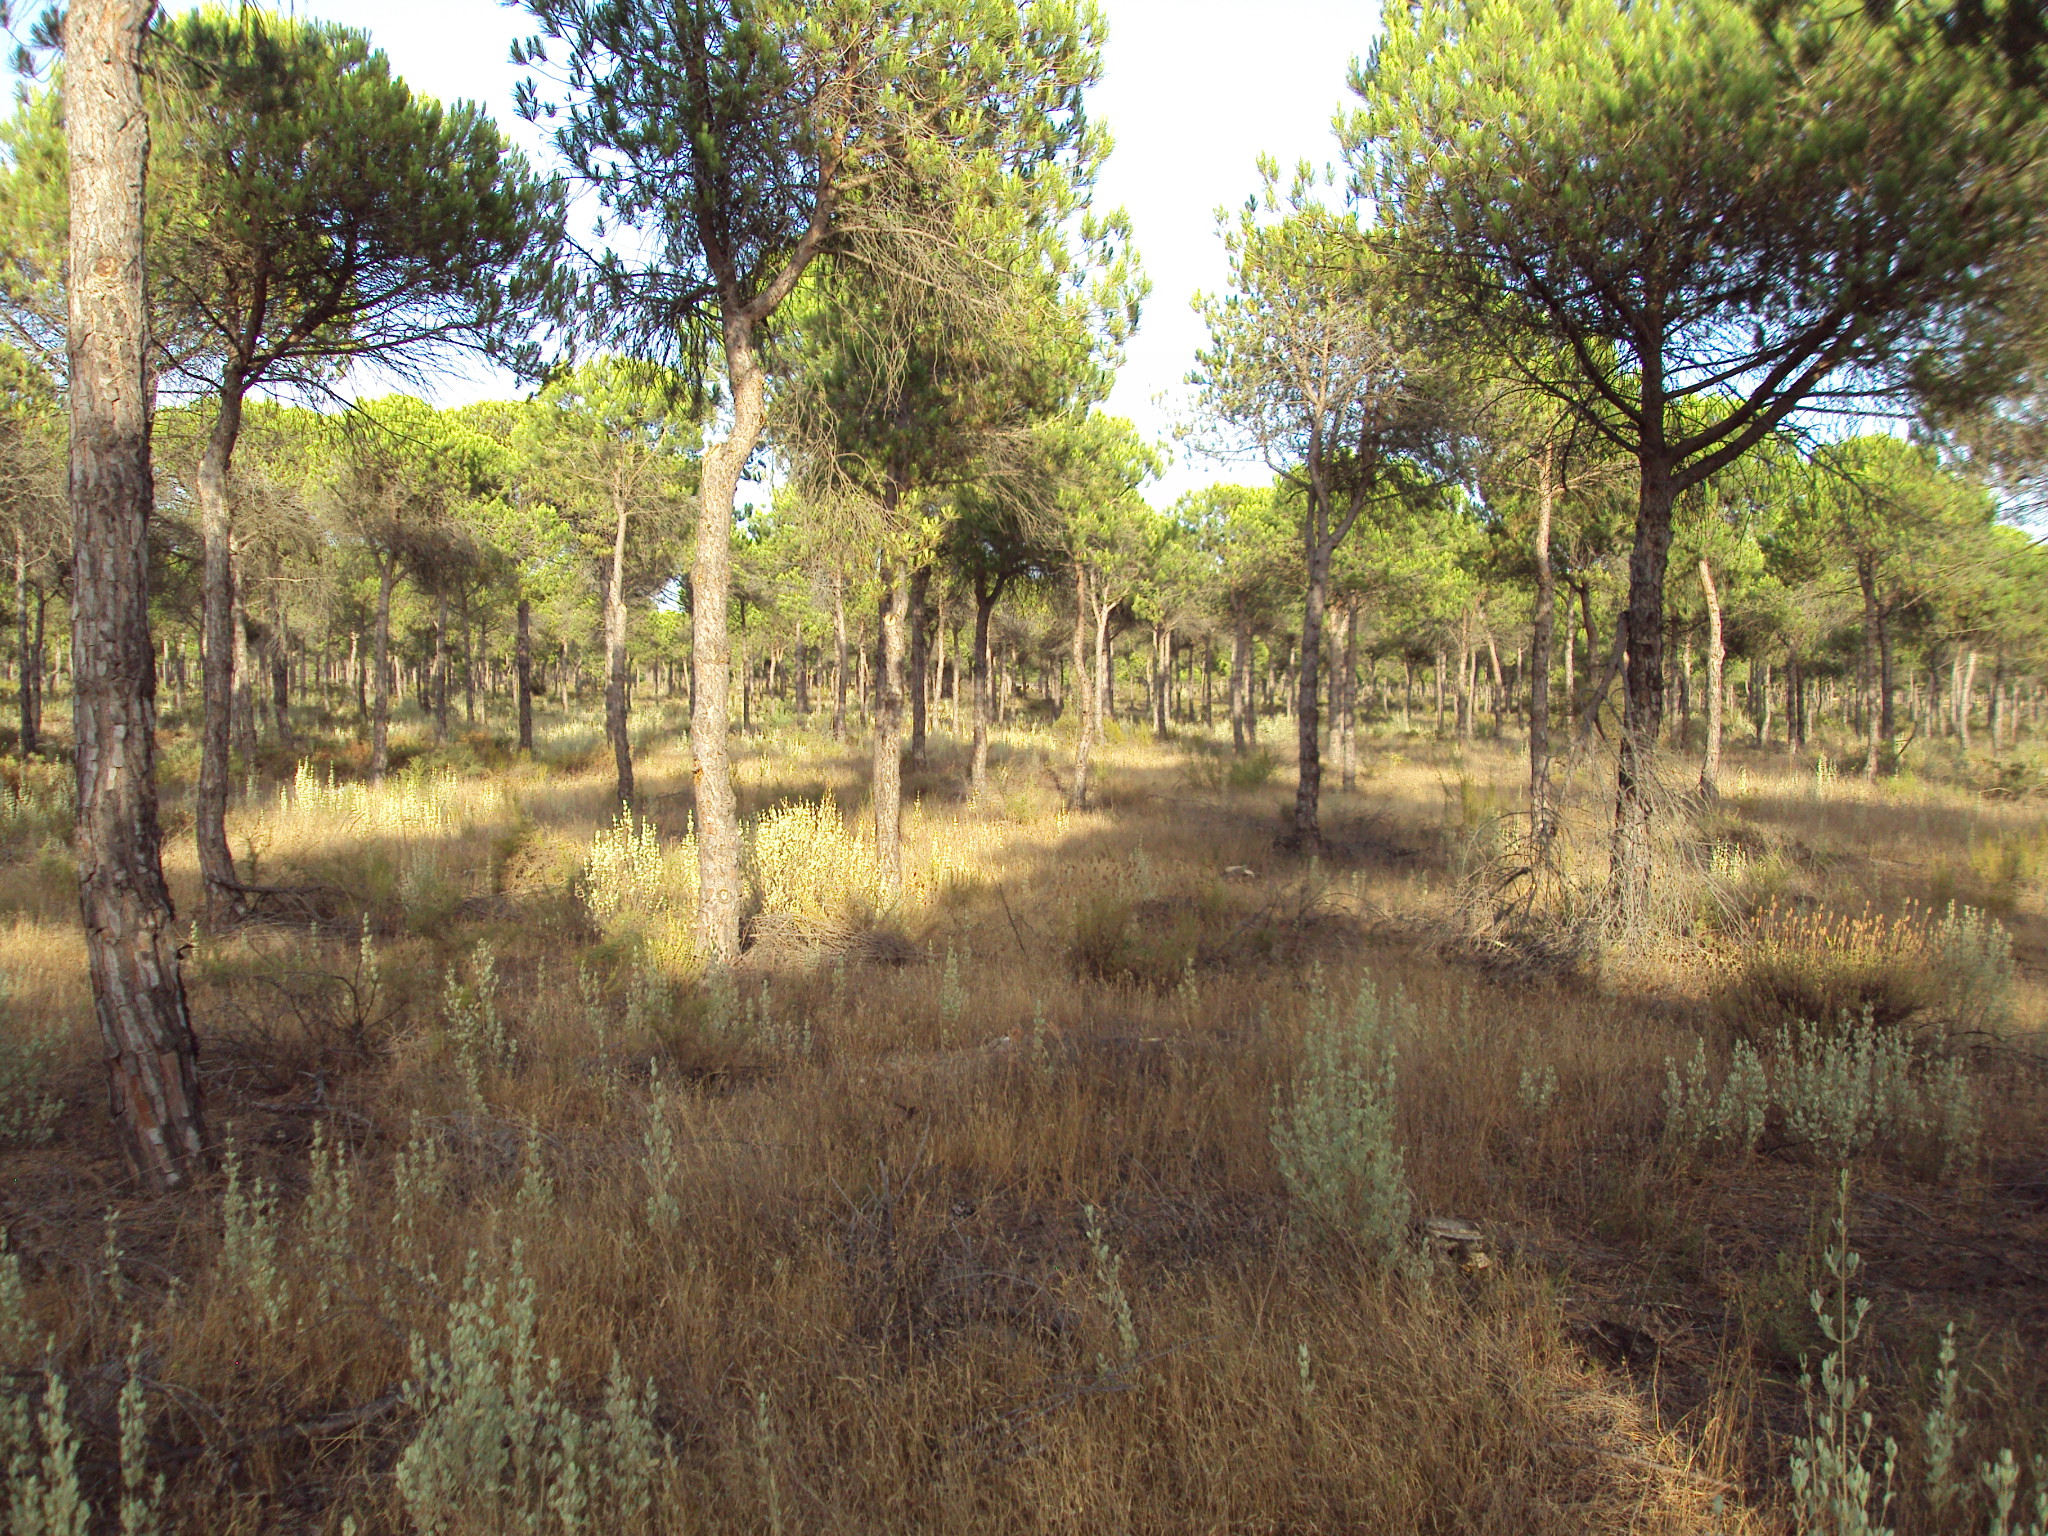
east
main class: Woodland
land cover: Pine dominated coniferous woodland
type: coniferous forest of the mediterranean region
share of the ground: 50 - 75 %
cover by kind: coniferous forest trees 60 %, shrubs 20 %, herbaceous plants 20 %
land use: Forestry
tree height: > 5 m
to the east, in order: Pine dominated coniferous woodland; Tracks; Pine dominated coniferous woodland
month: July
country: ES
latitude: 37.1429
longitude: -6.8193
